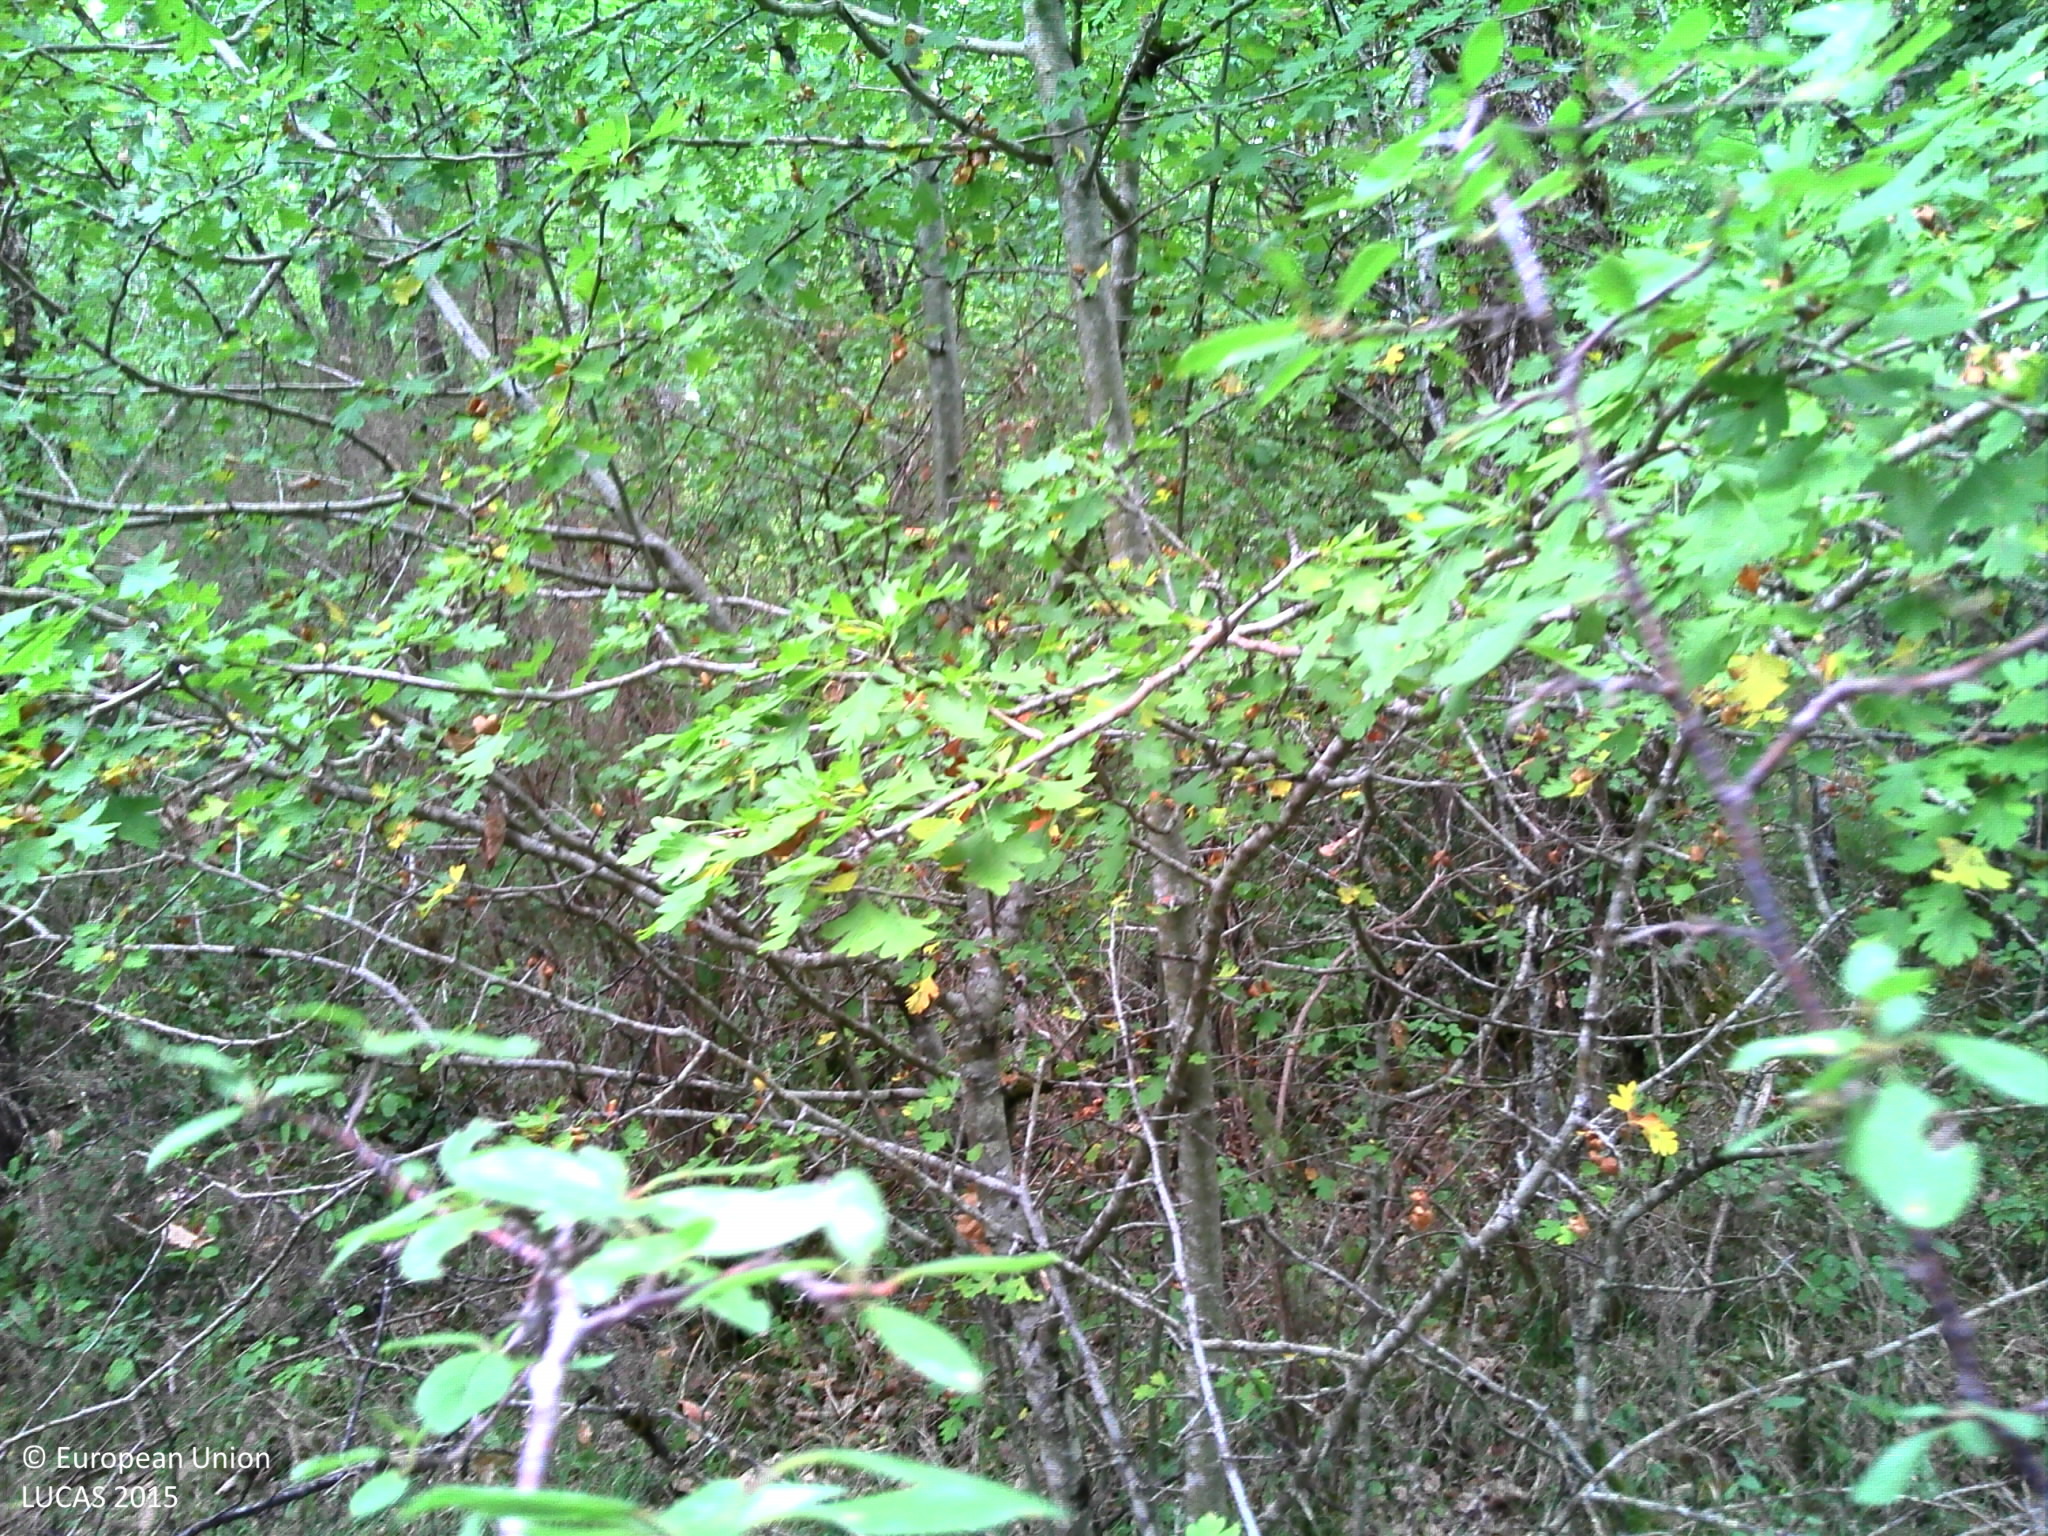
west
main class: Woodland
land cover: Broadleaved woodland
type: acidophilous oak and oak-birch forest
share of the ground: > 75 %
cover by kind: broadleaved forest trees 75 %, shrubs 10 %, herbaceous plants 10 %, lichens and mosses 5 %
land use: Forestry
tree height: > 5 m
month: July
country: FR
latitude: 45.0254
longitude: 1.1733
